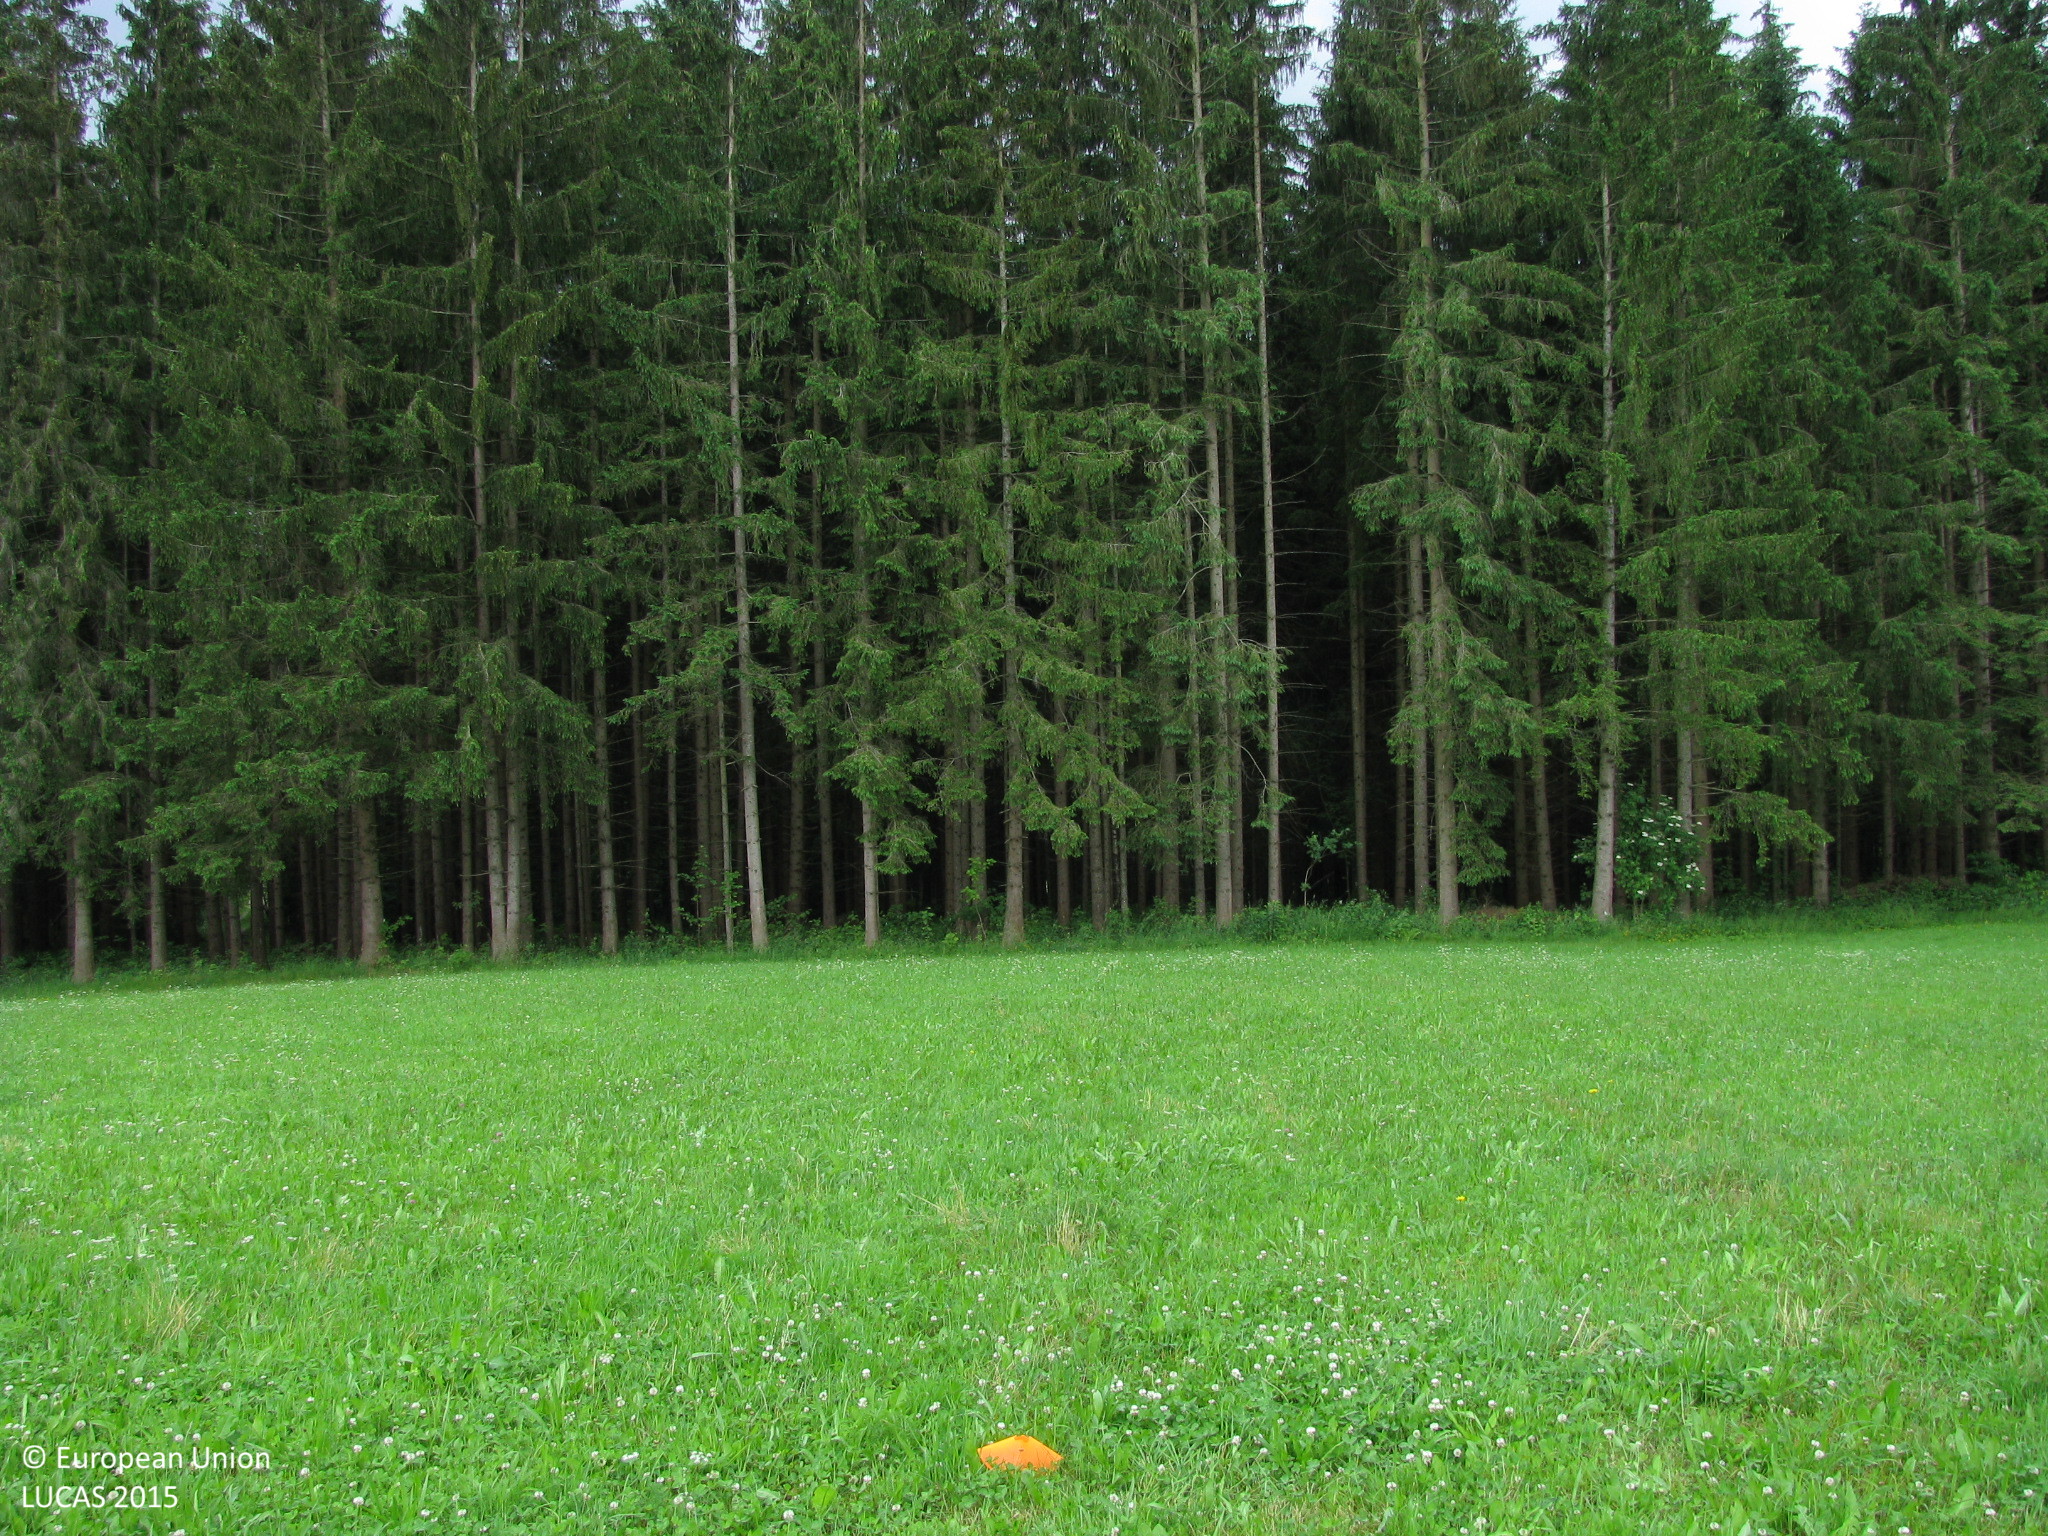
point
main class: Grassland
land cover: Grassland without tree/shrub cover
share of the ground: > 75 %
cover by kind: herbaceous plants 100 %
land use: Agriculture (excluding fallow land and kitchen gardens)
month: June
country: AT
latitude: 47.2741
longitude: 14.7446
